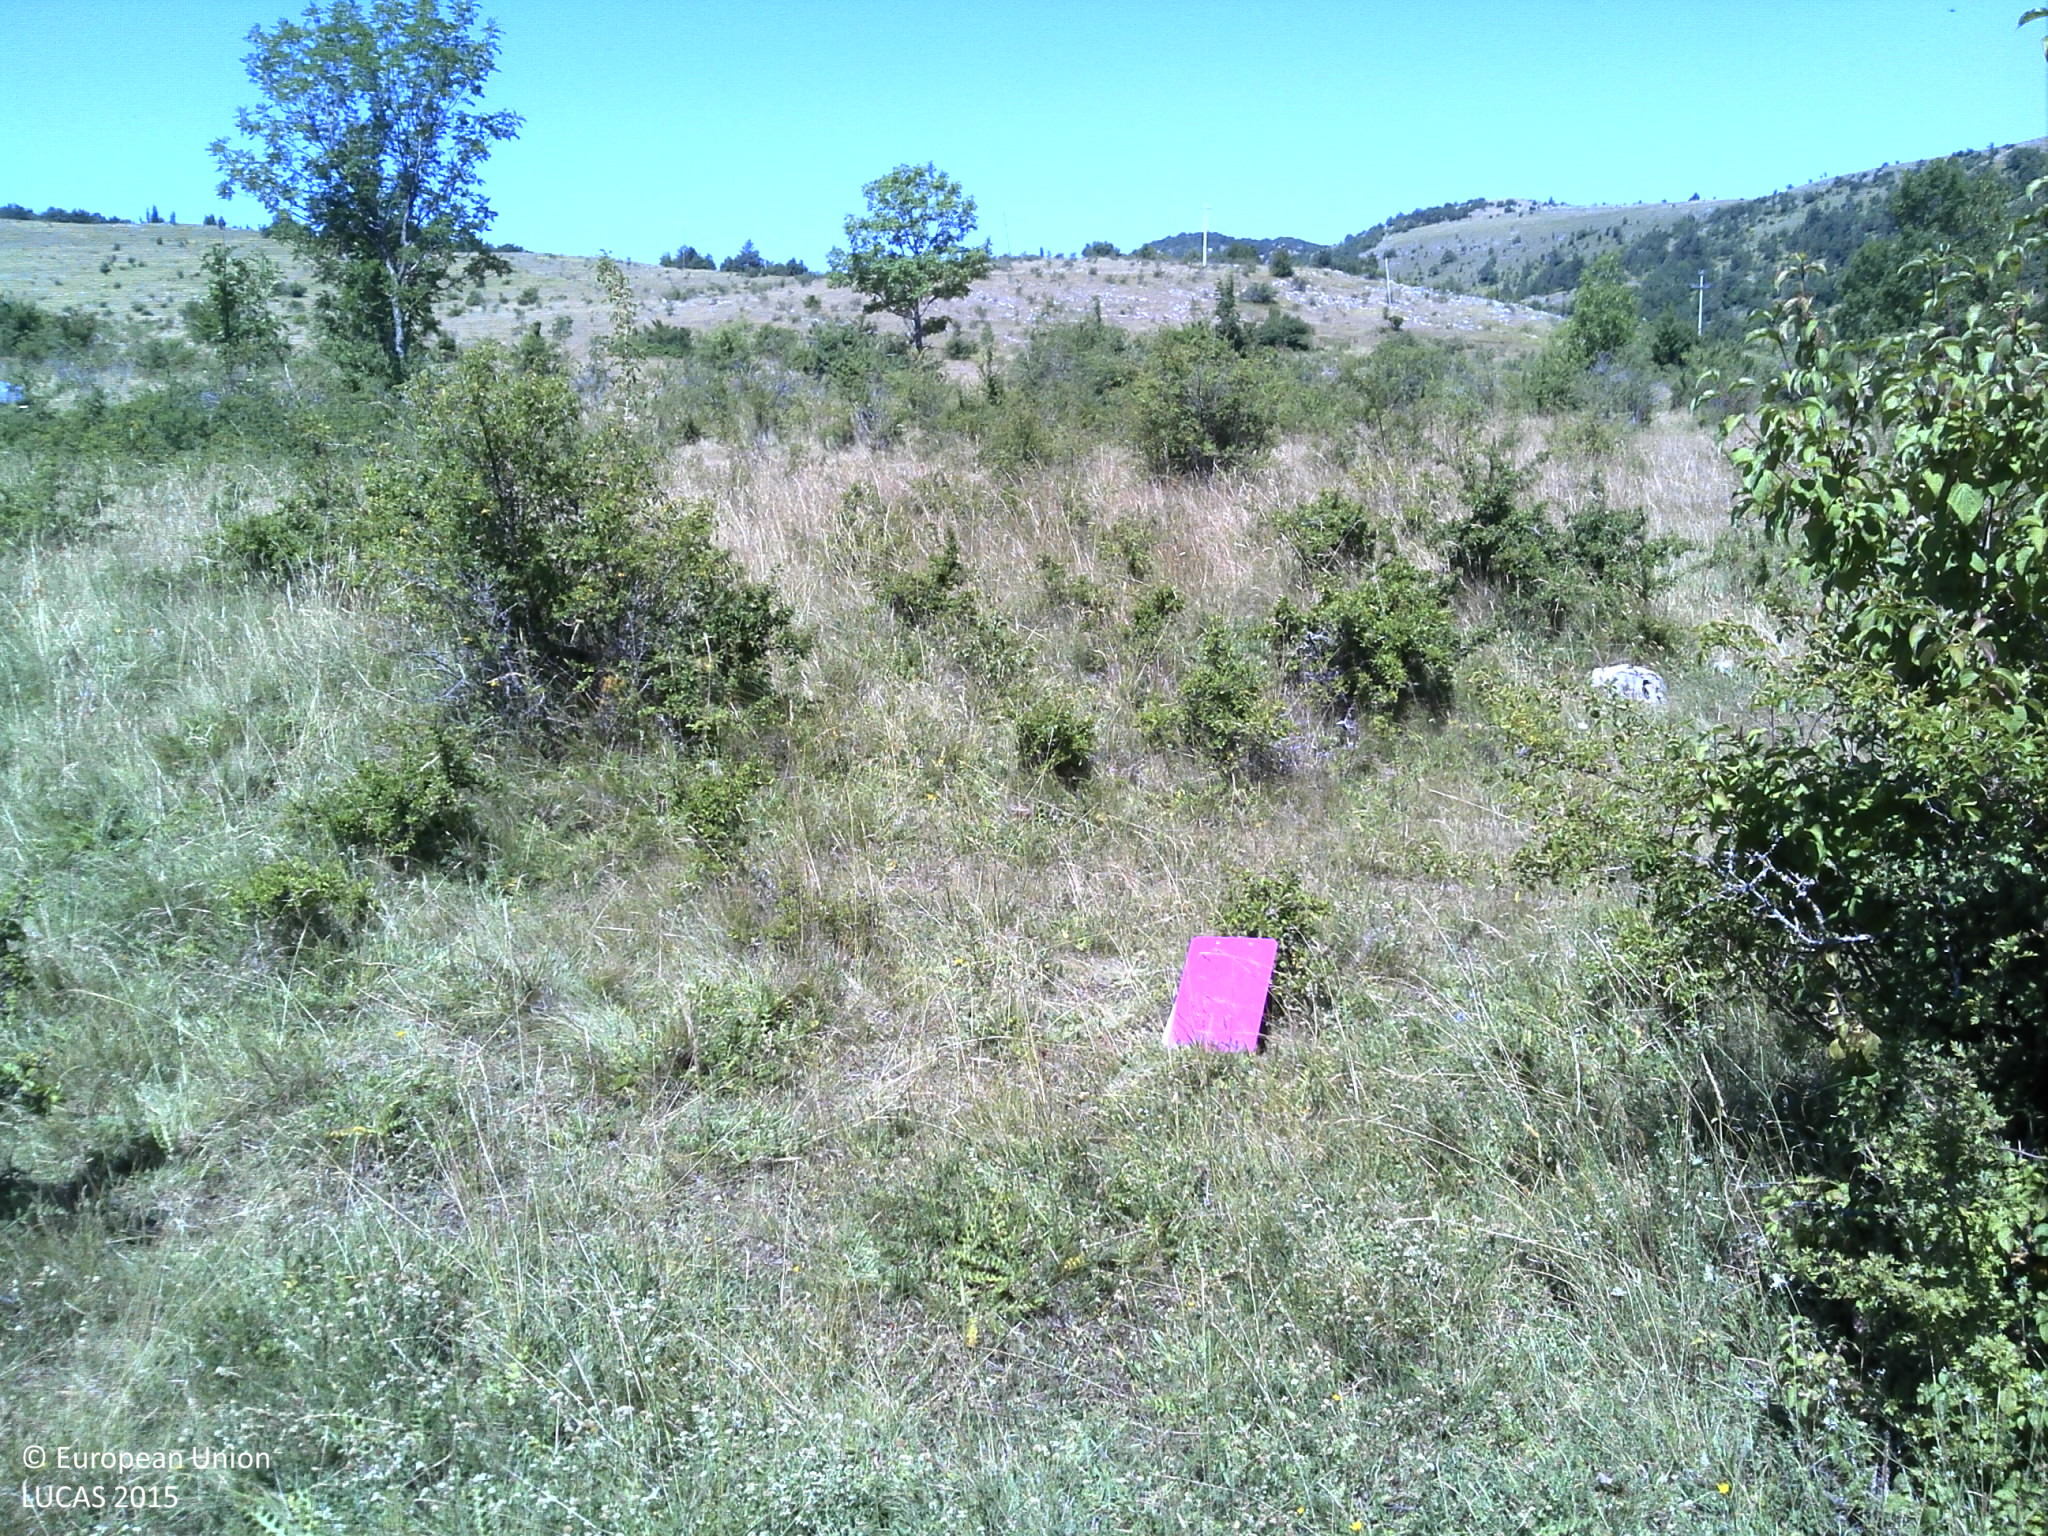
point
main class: Shrubland
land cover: Shrubland with sparse tree cover
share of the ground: 25 - 50 %
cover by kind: herbaceous plants 55 %, shrubs 40 %, broadleaved forest trees 5 %
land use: Semi-natural and natural areas not in use
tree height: < 5 m
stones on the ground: < 10 %
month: July
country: HR
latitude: 44.4006
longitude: 15.8820
